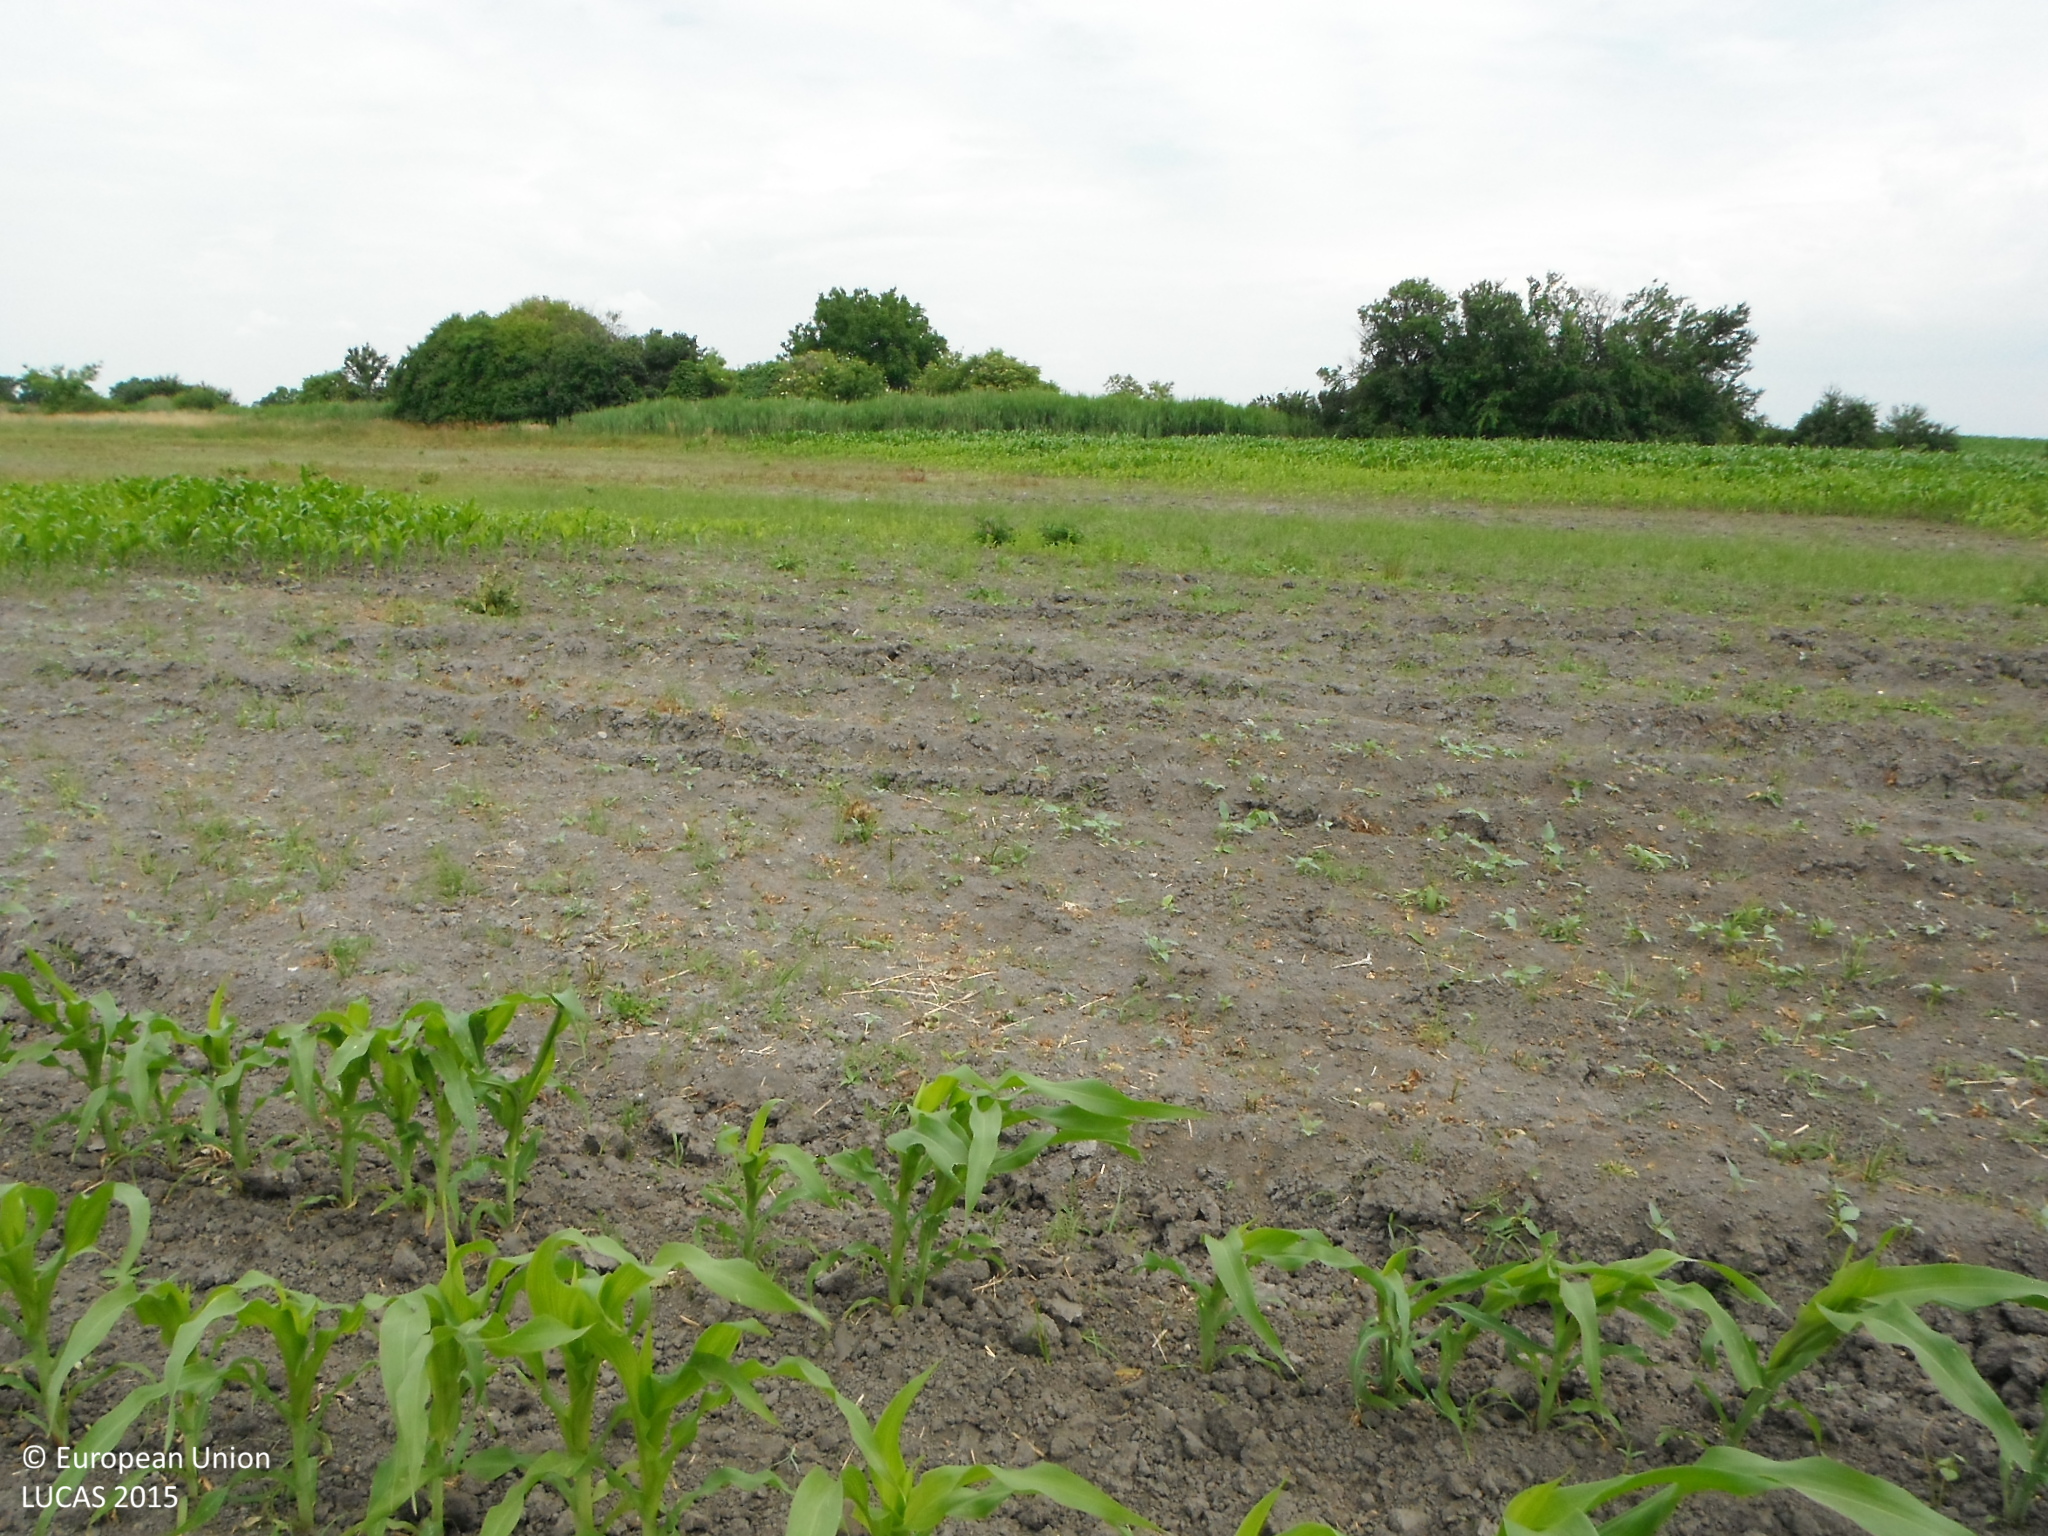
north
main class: Cropland
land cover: Maize
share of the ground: 50 - 75 %
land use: Agriculture (excluding fallow land and kitchen gardens)
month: June
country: SK
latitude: 48.2037
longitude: 17.7483
